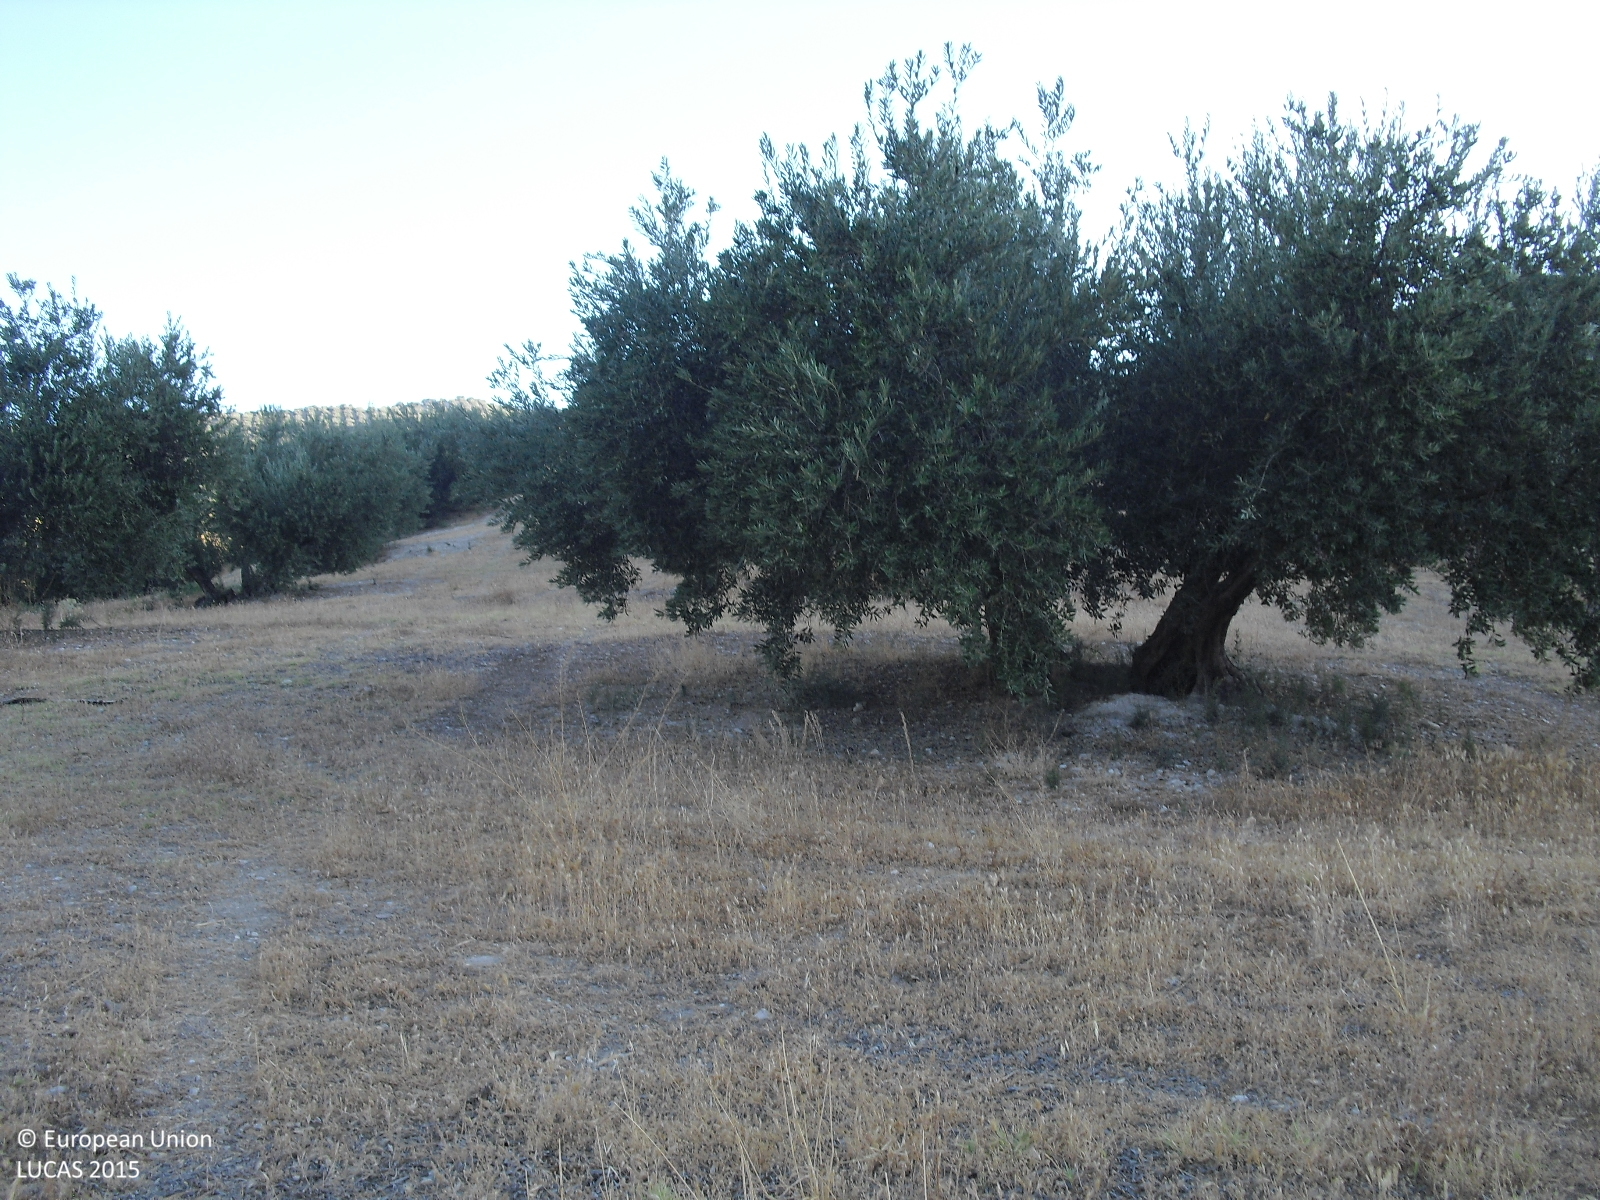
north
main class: Cropland
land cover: Olive groves
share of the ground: 10 - 25 %
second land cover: Spontaneously vegetated surfaces
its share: 25 - 50 %
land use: Agriculture (excluding fallow land and kitchen gardens)
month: August
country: ES
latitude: 37.2607
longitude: -4.1015
